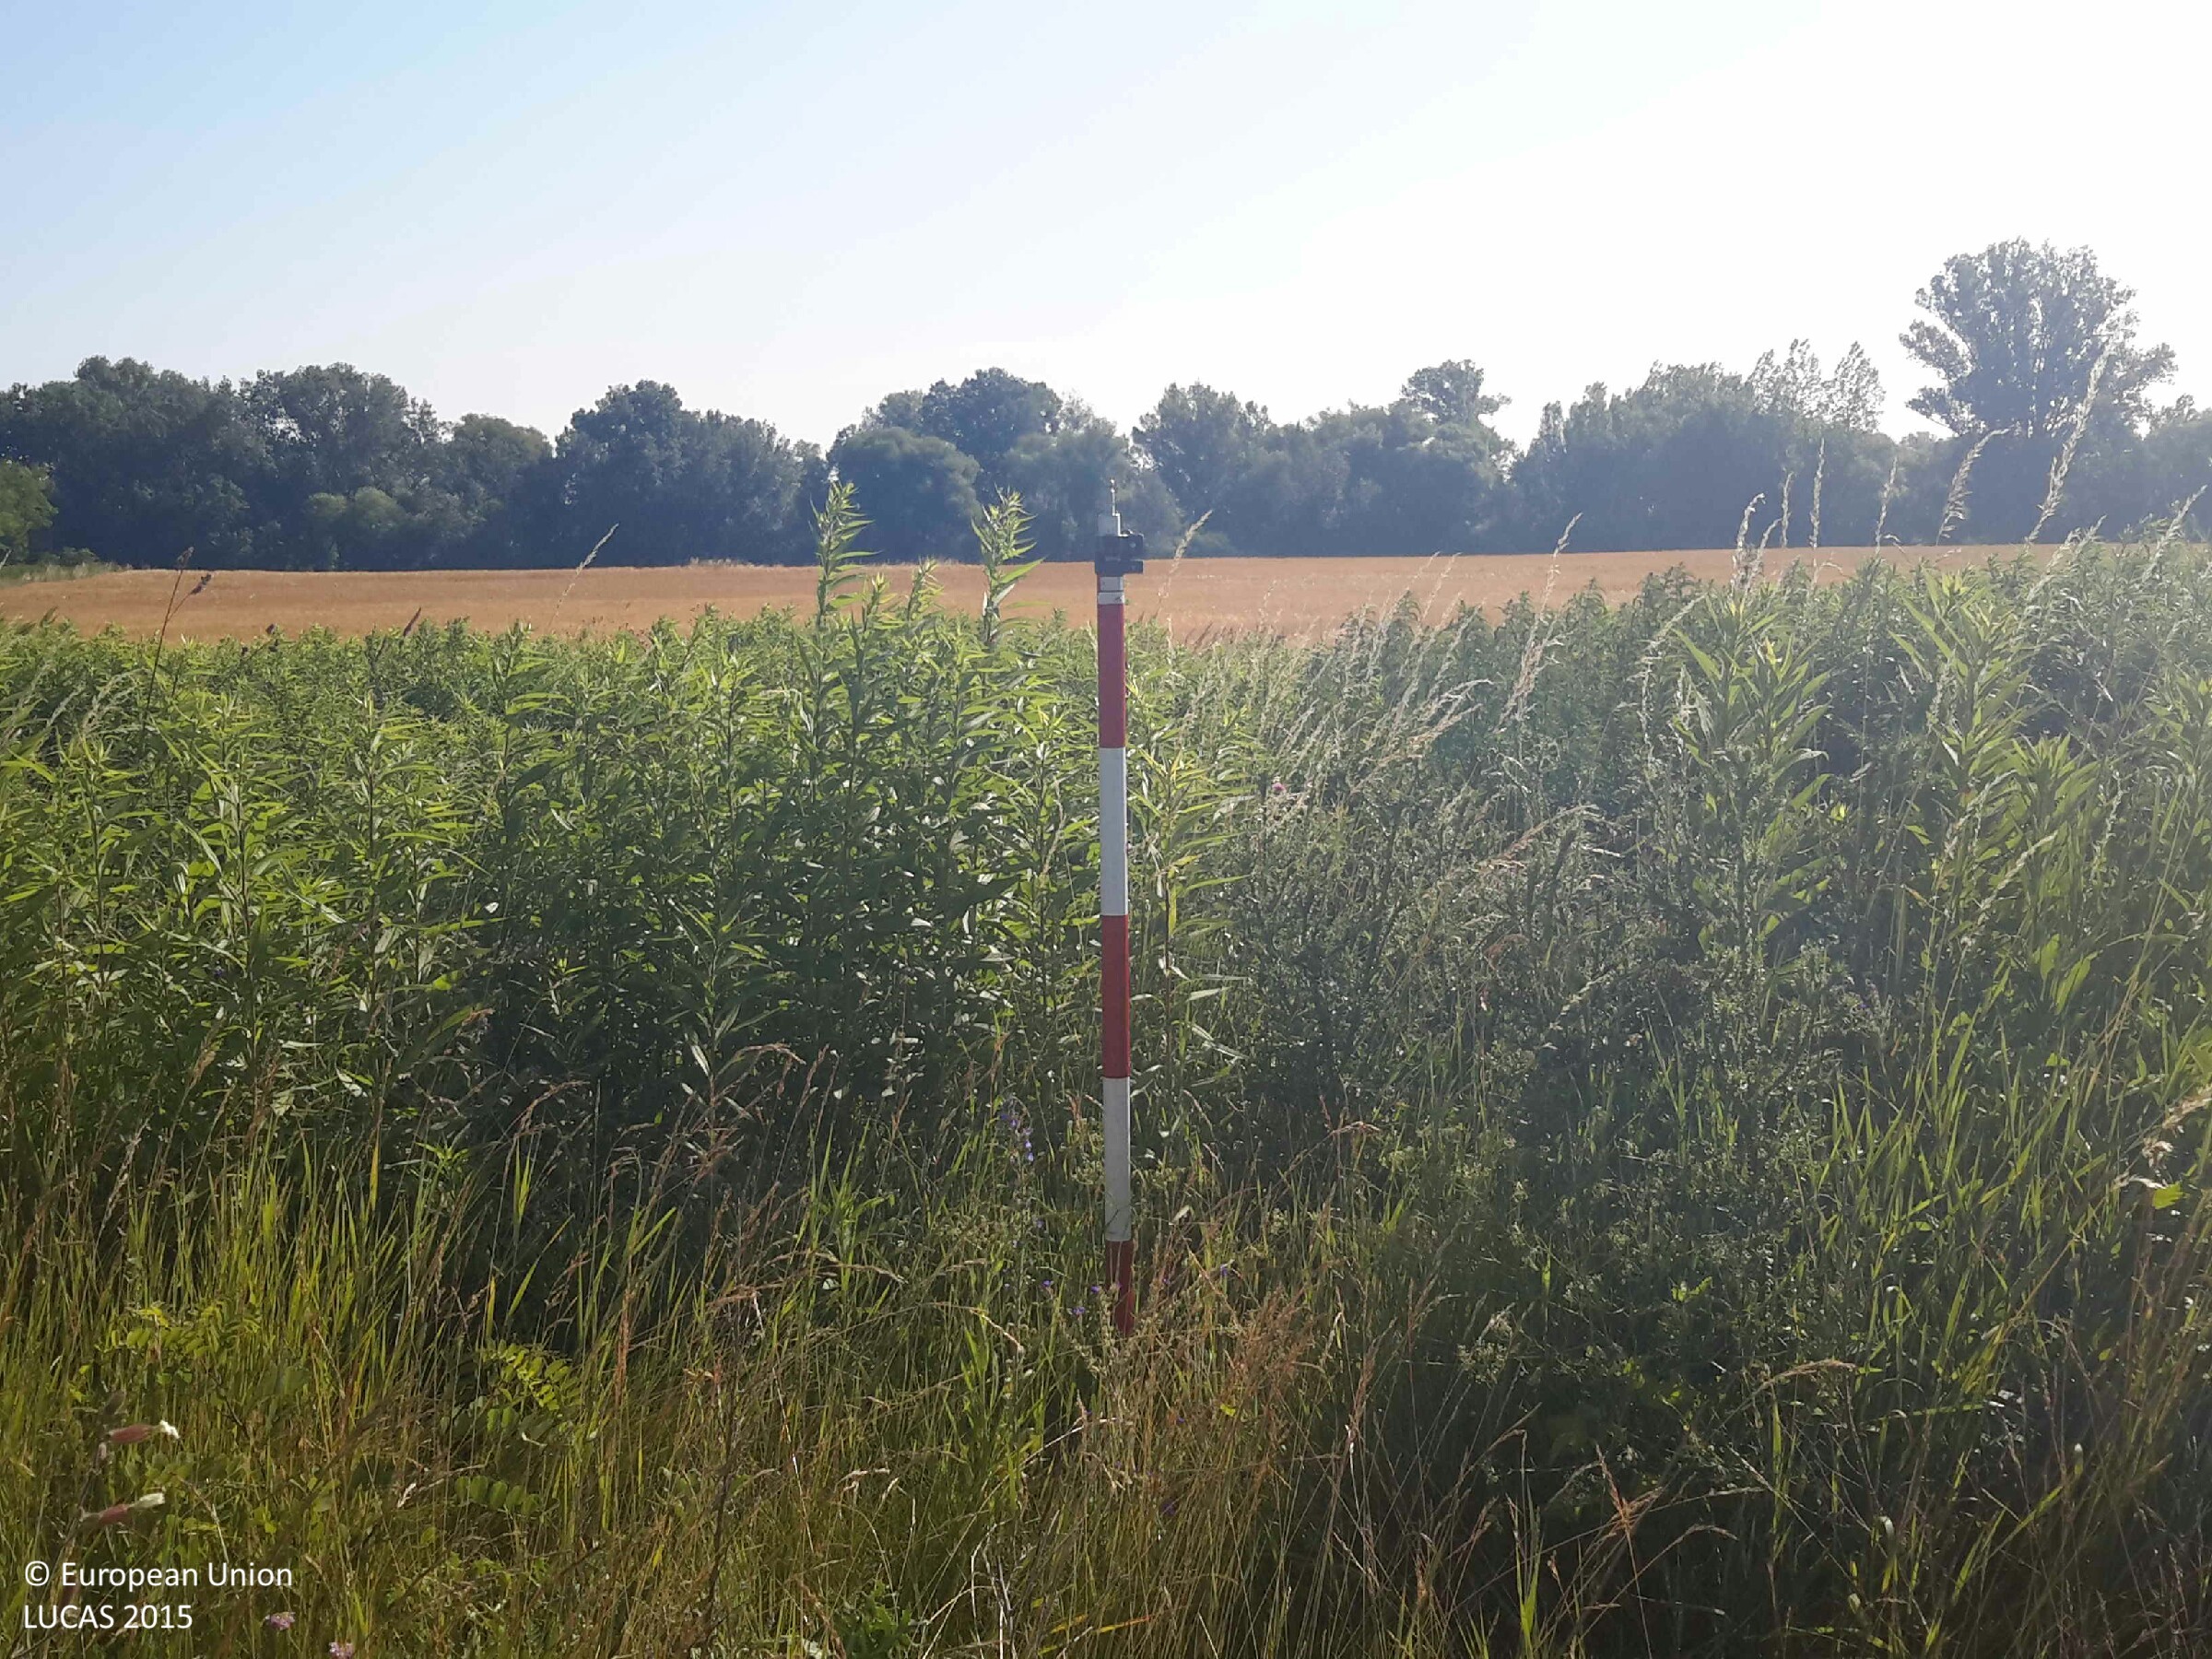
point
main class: Grassland
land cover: Spontaneously vegetated surfaces
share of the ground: > 75 %
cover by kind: herbaceous plants 100 %
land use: Abandoned areas
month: June
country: HU
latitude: 47.6693
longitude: 17.3727
